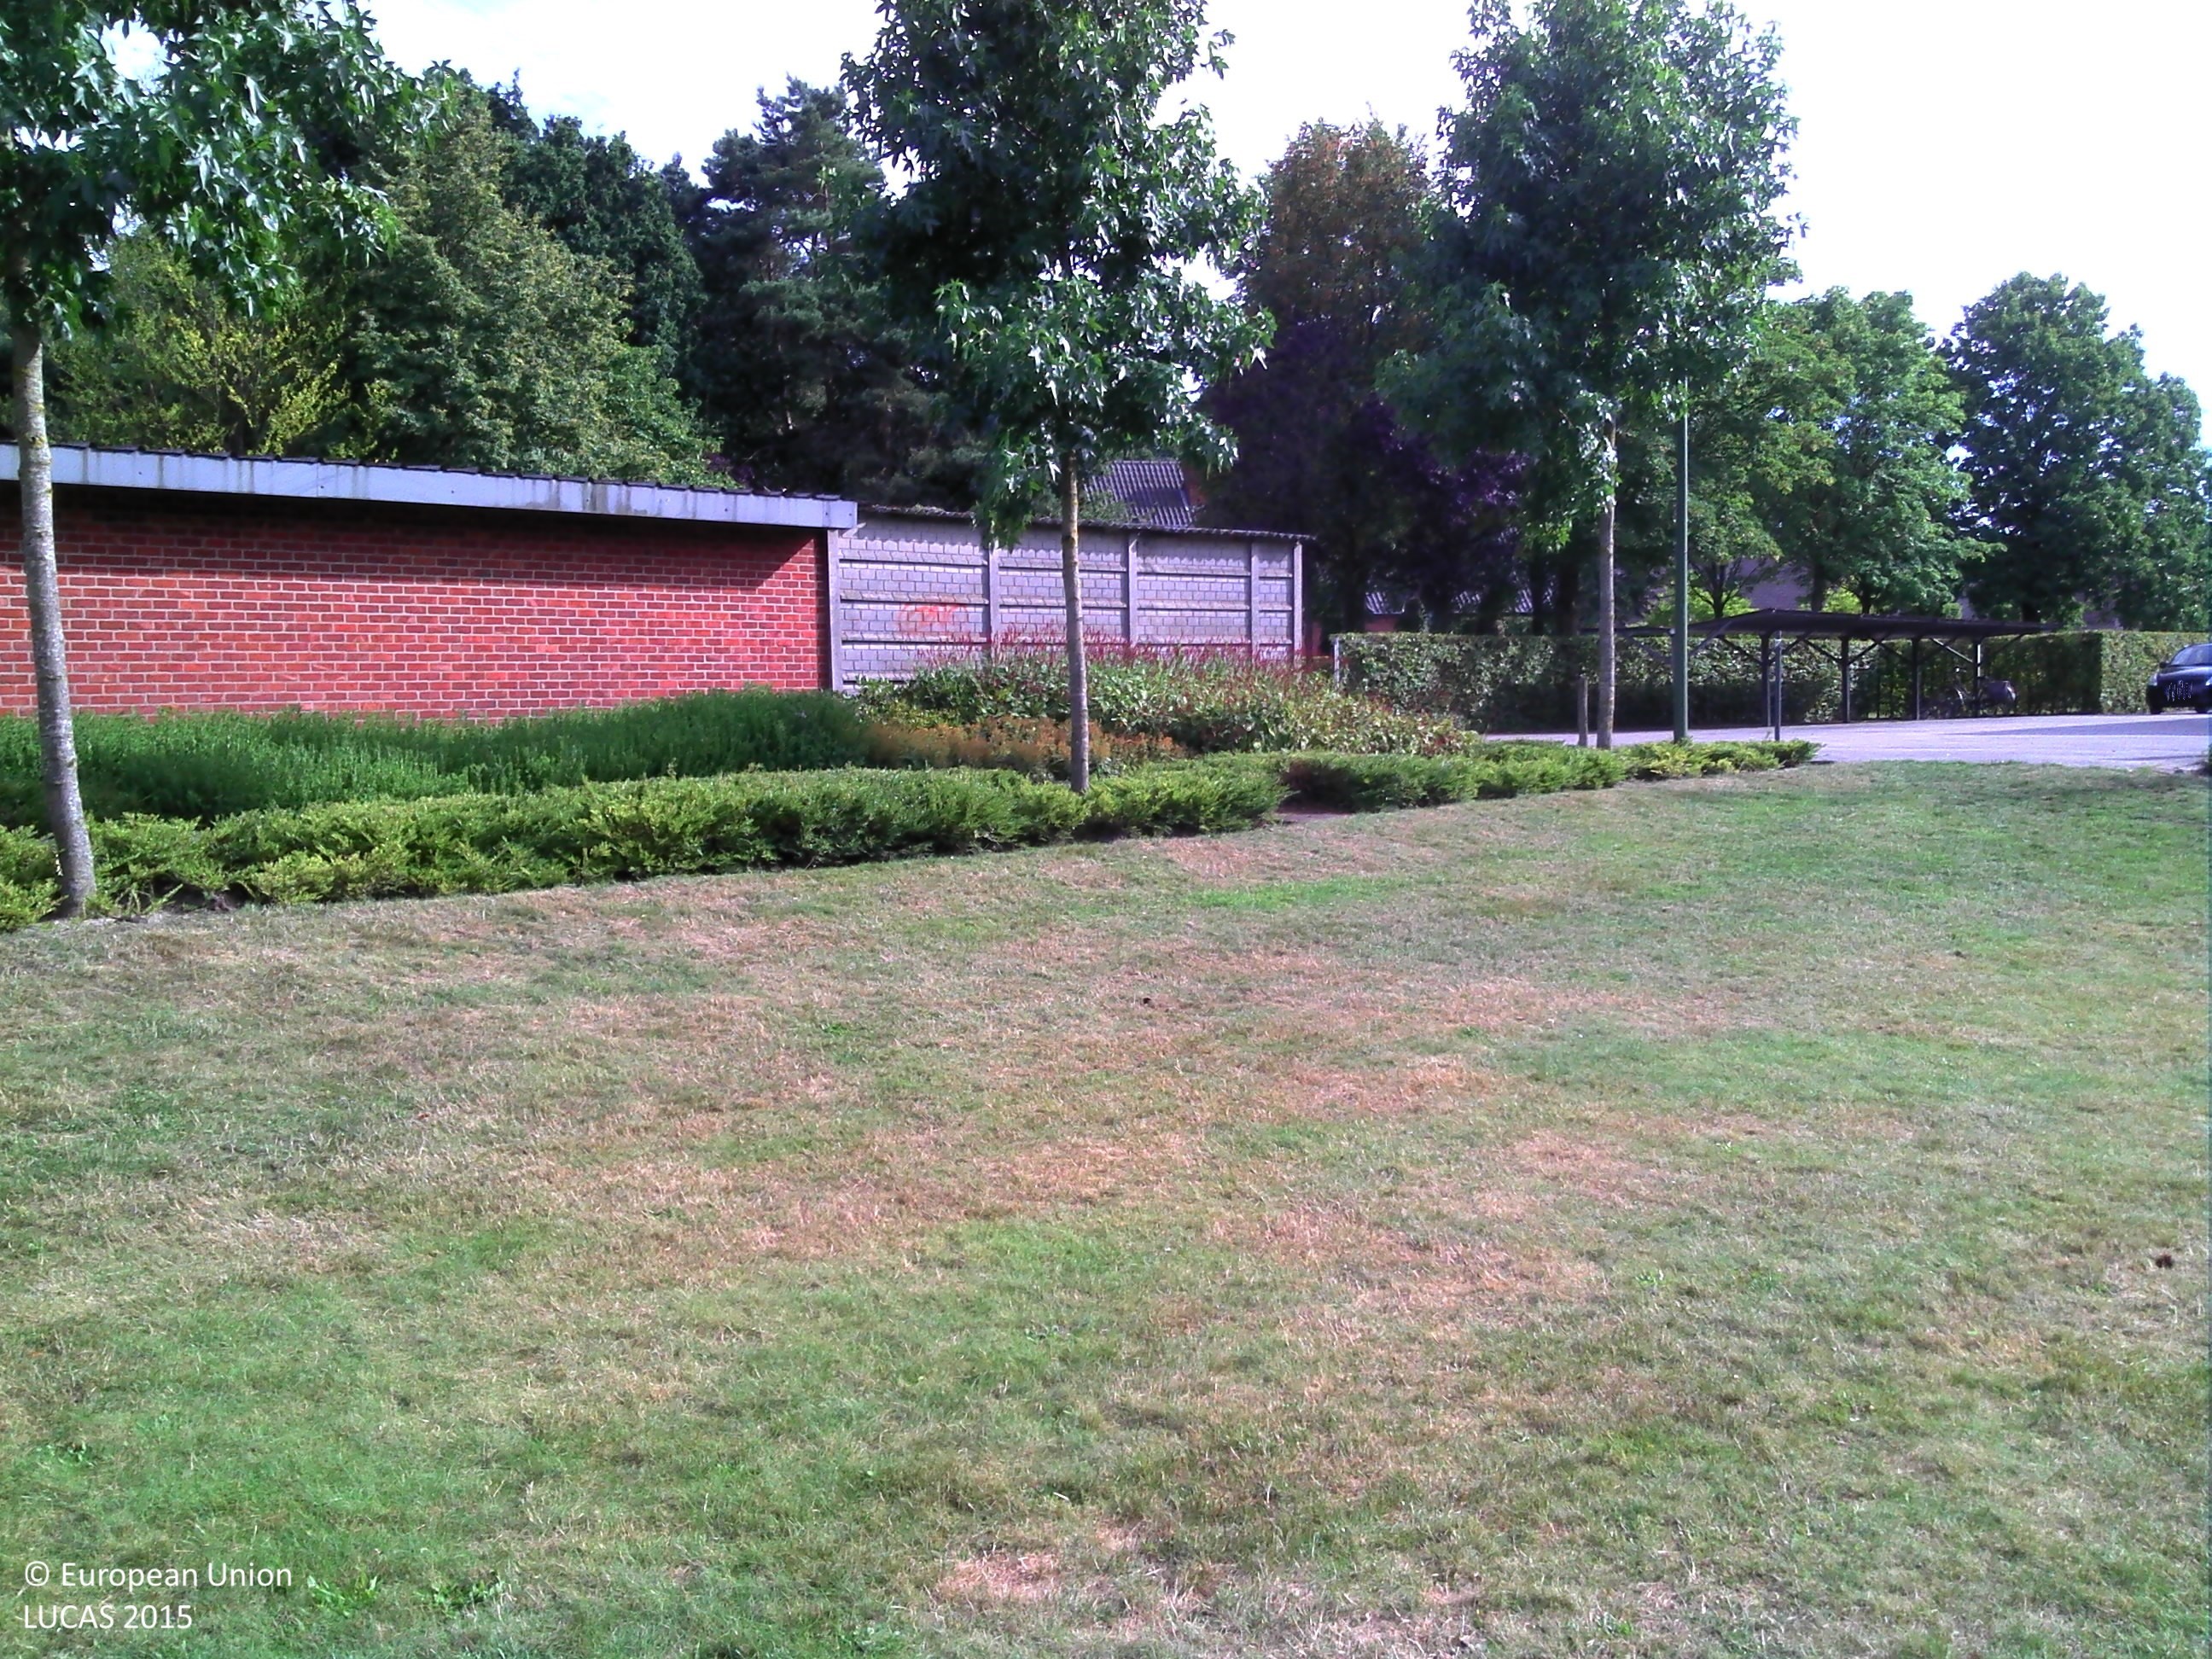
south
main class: Grassland
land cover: Grassland without tree/shrub cover
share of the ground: > 75 %
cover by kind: herbaceous plants 100 %
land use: Amenities, museums, leisure
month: August
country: BE
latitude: 51.1061
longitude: 5.5564
